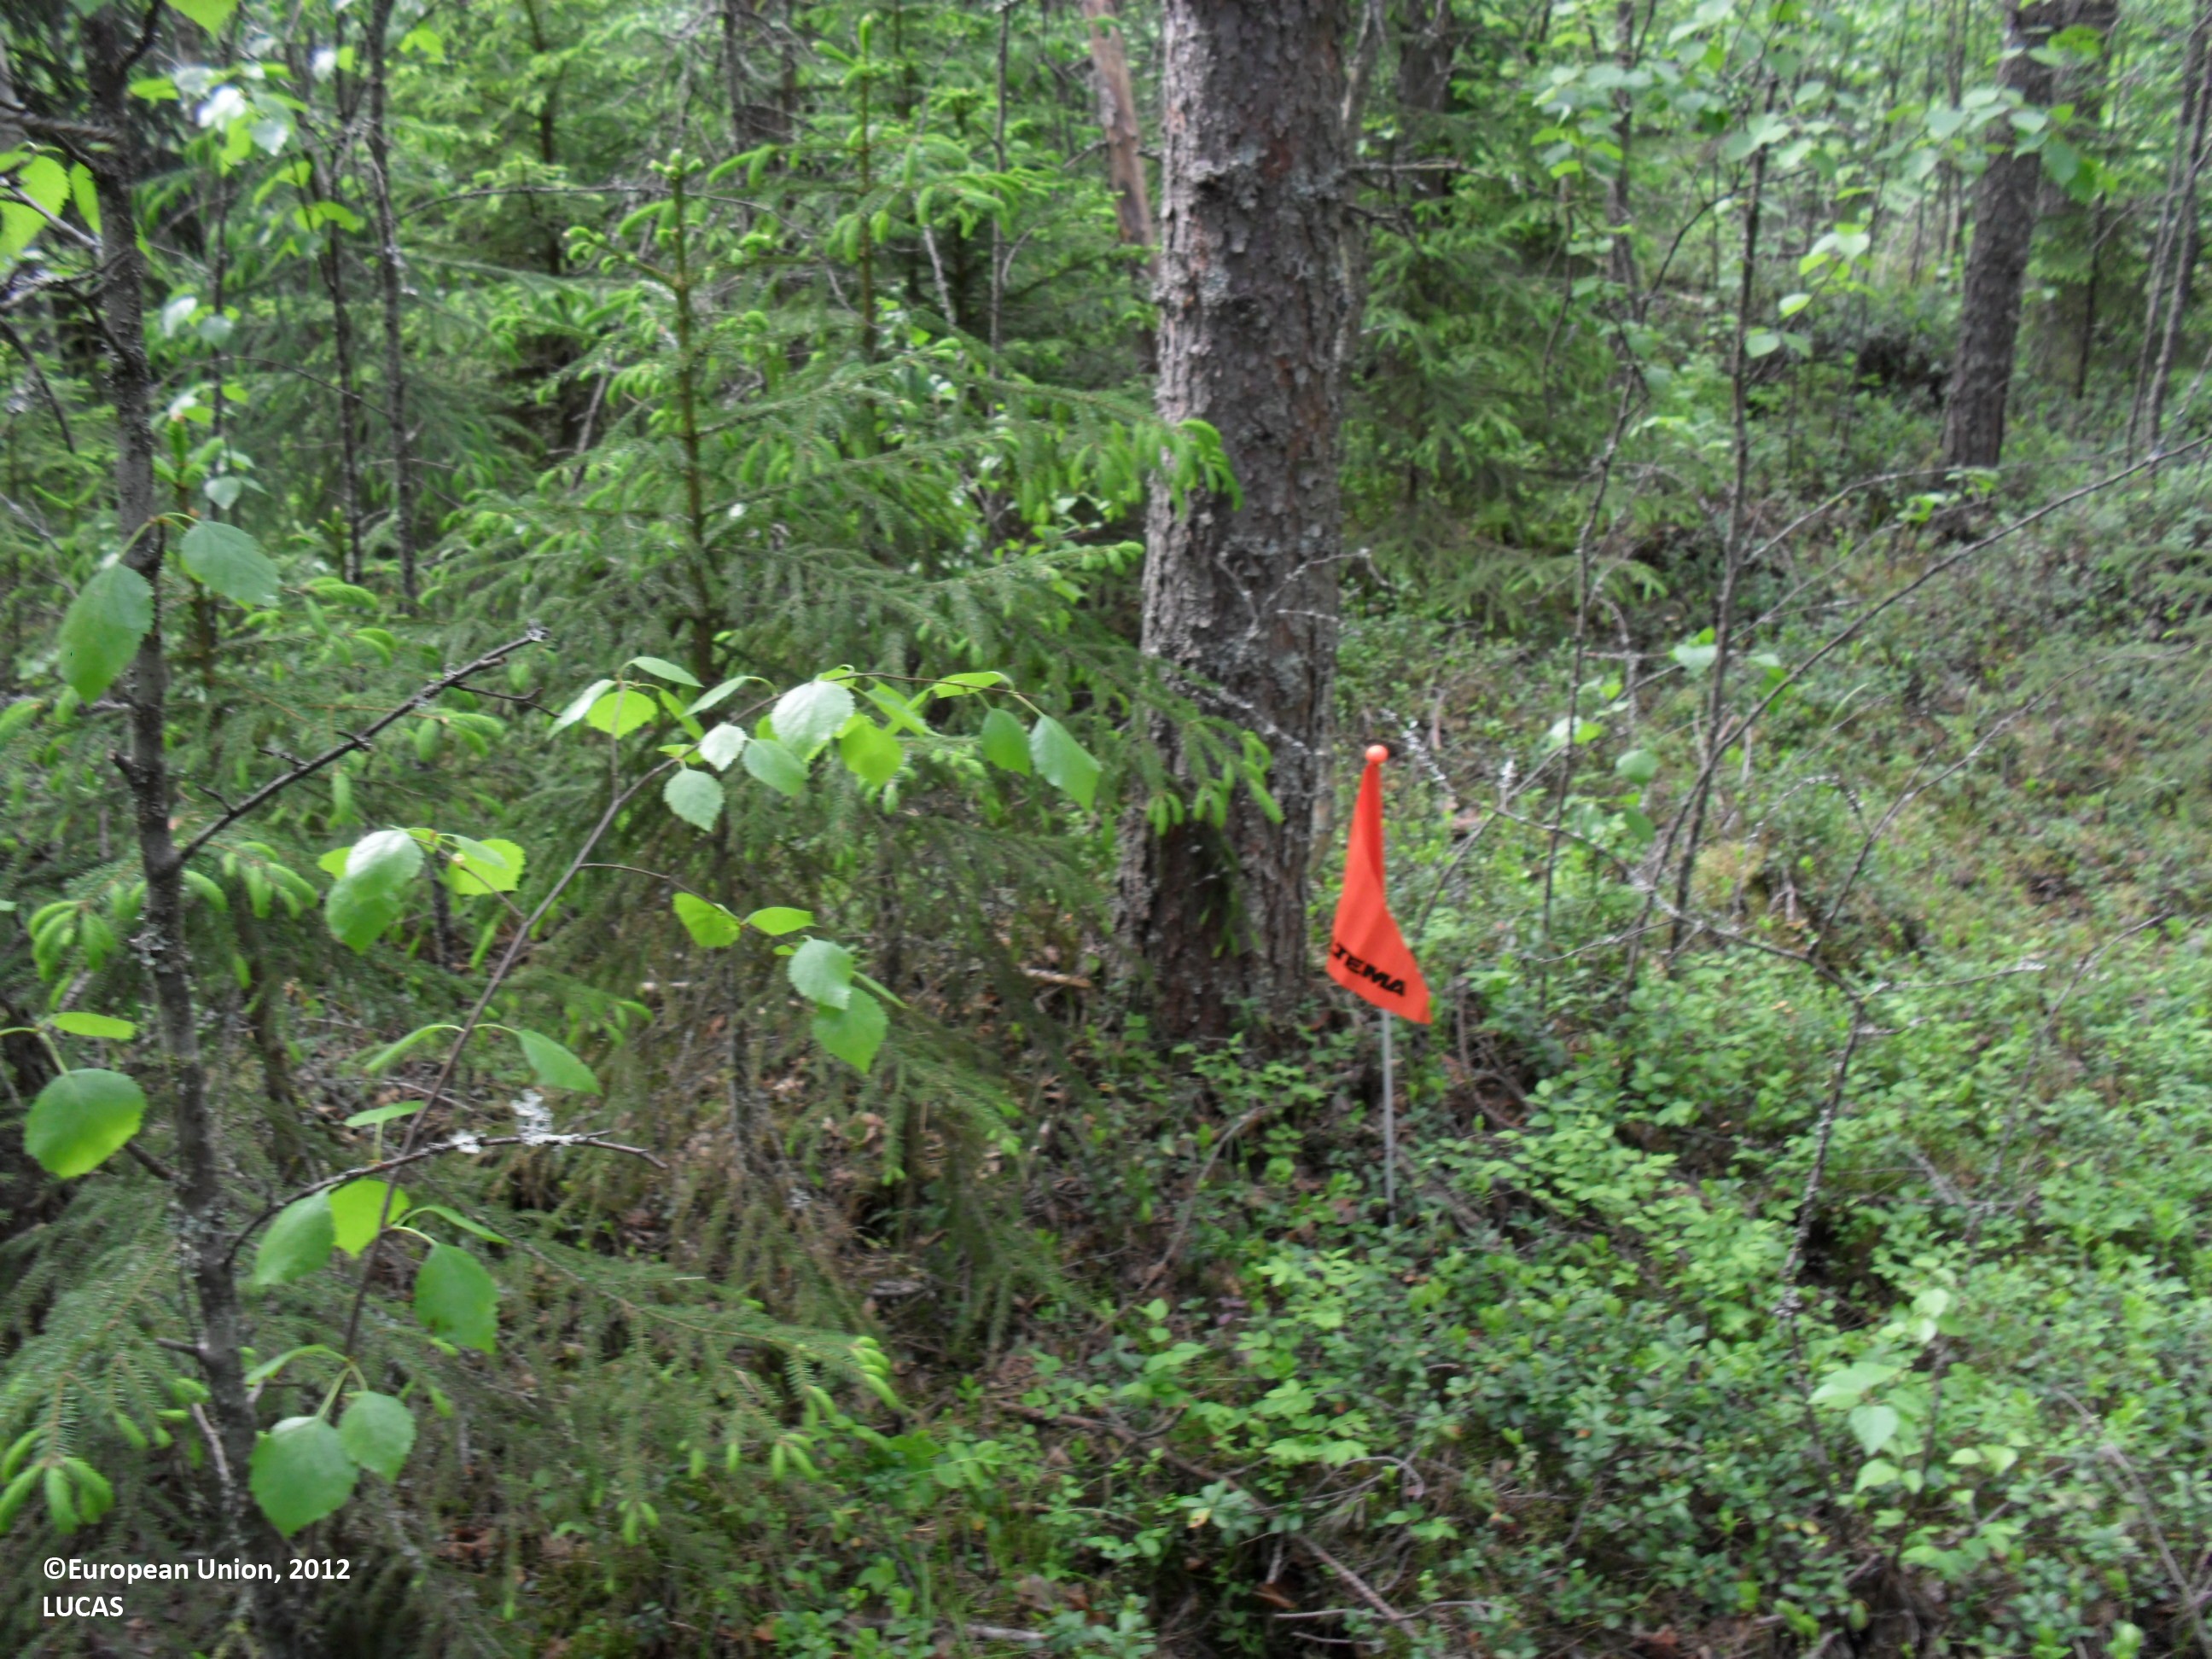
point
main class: Woodland
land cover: Pine dominated mixed woodland
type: boreal forest
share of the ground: 50 - 75 %
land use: Forestry
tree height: > 5 m
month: June
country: FI
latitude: 62.8850
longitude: 23.4598
